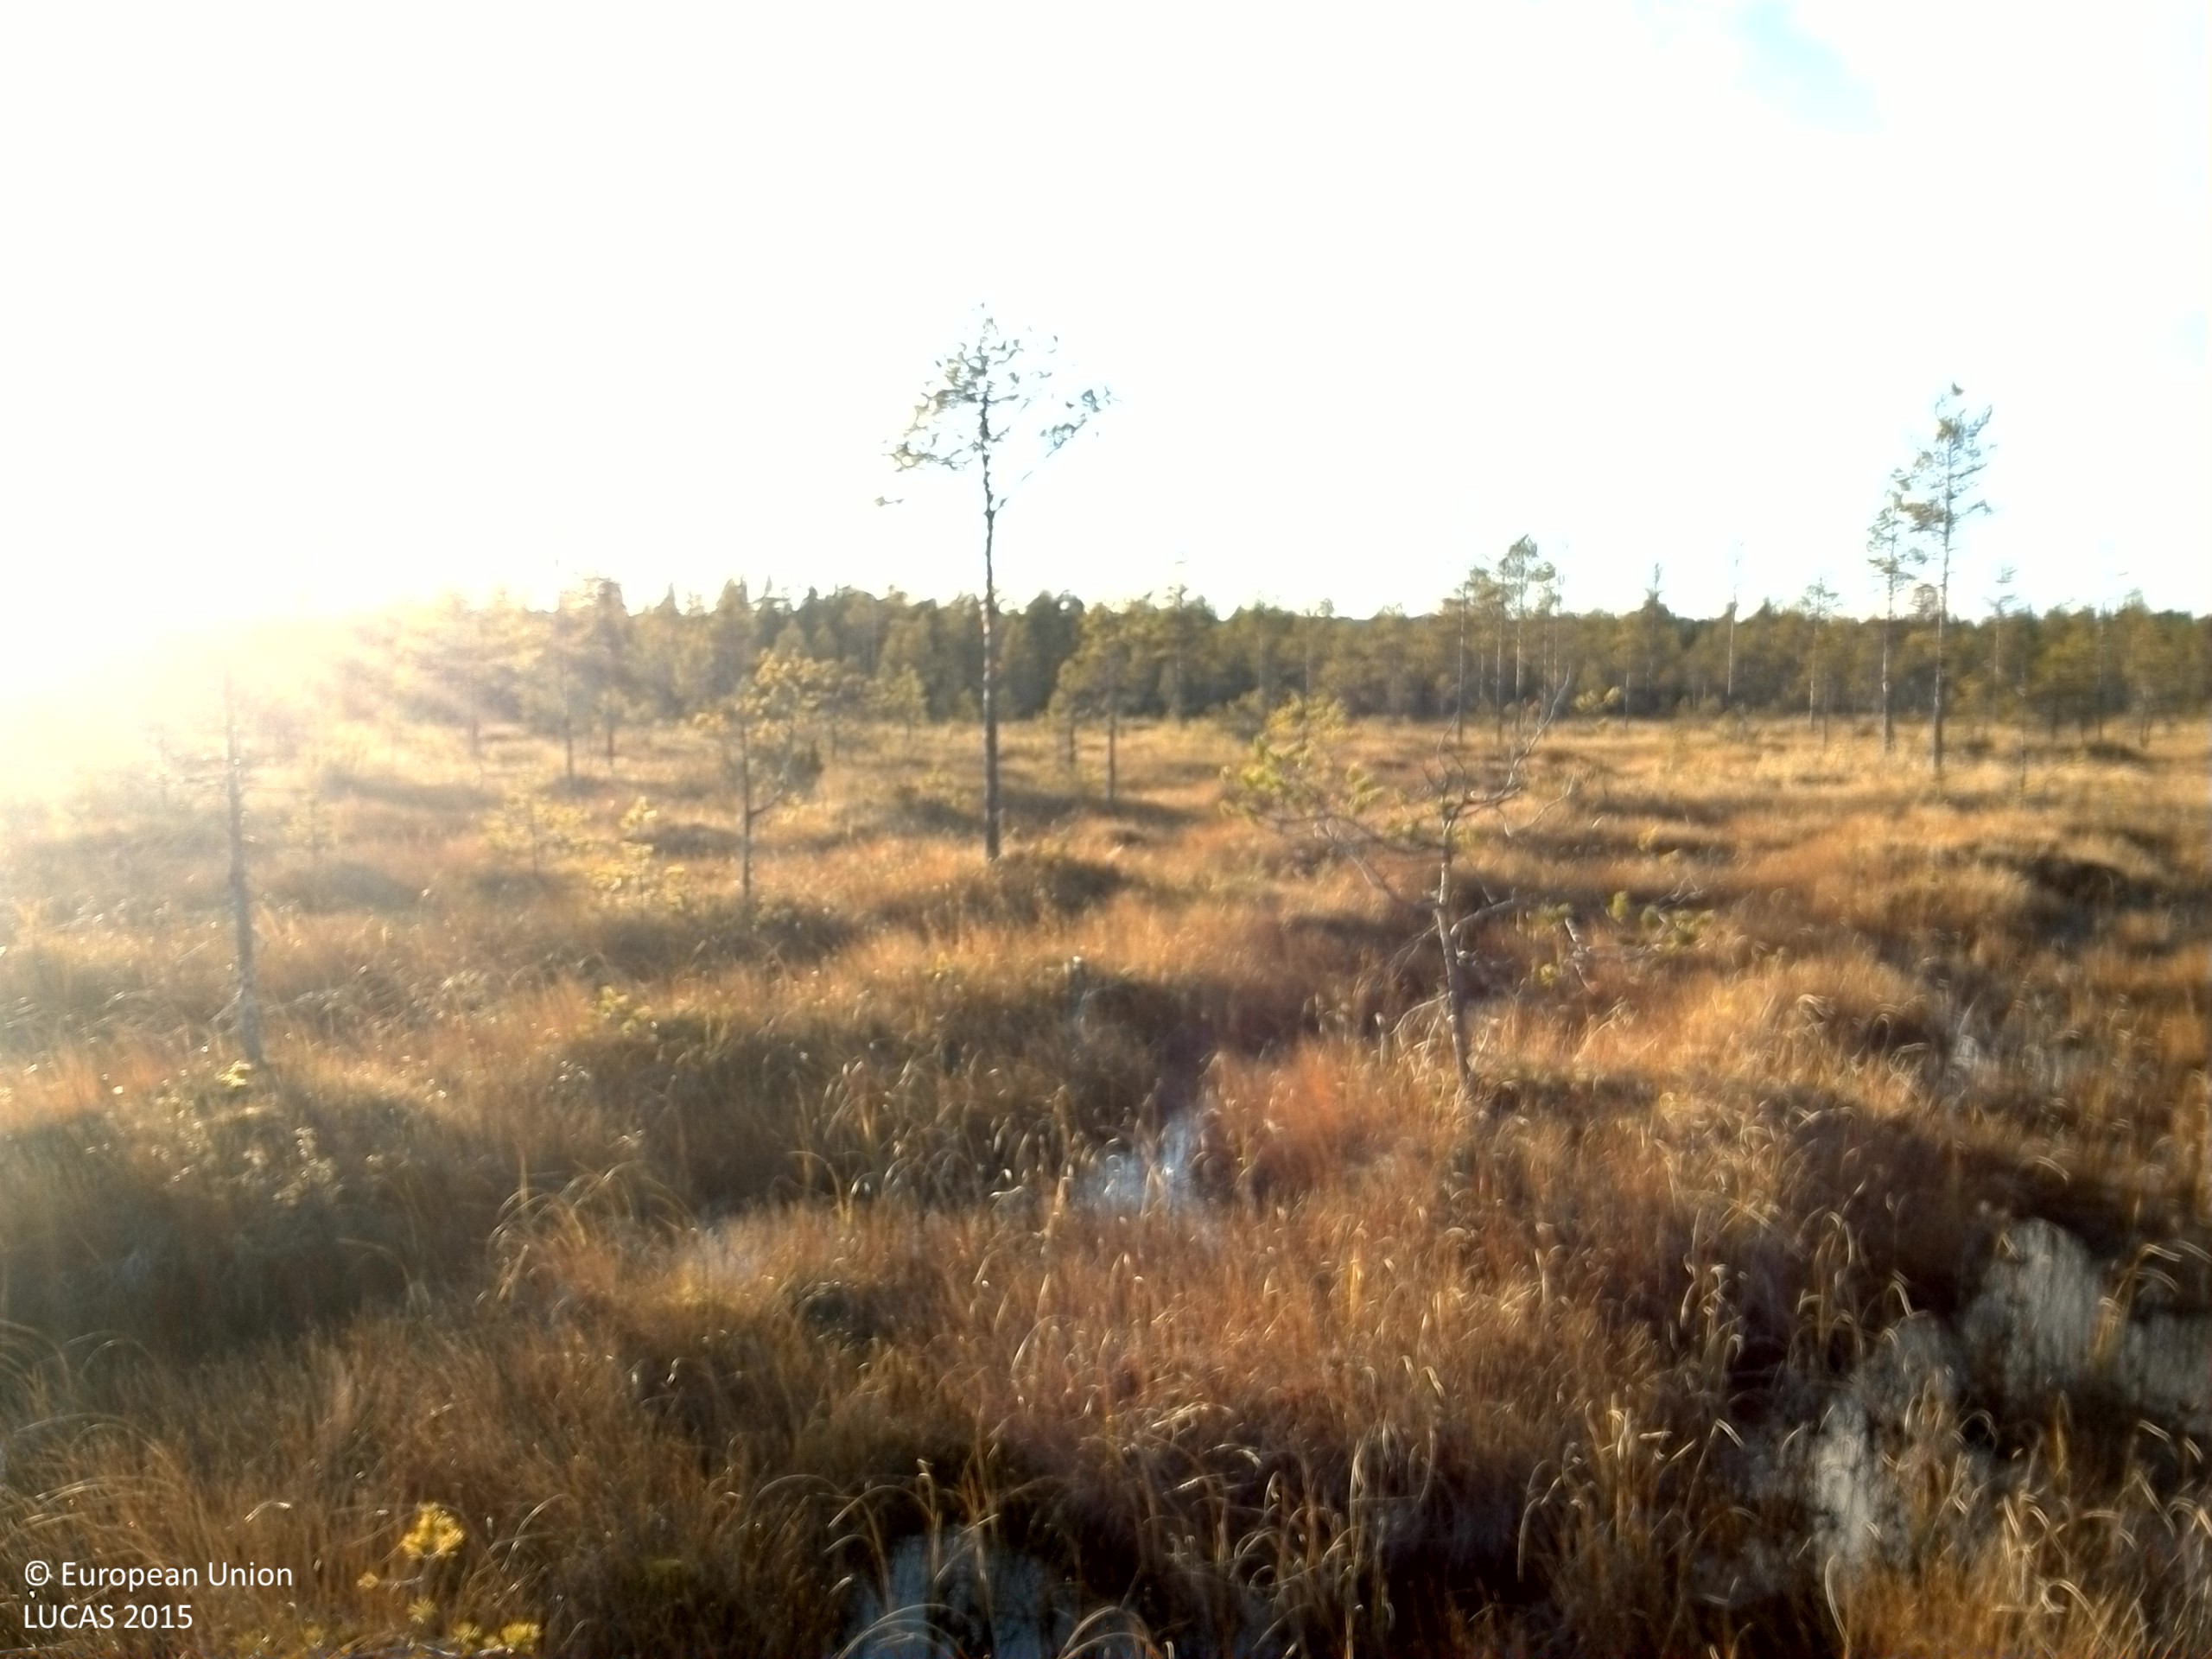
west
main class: Woodland
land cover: Pine dominated coniferous woodland
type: mire and swamp forests
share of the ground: 10 - 25 %
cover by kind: herbaceous plants 50 %, lichens and mosses 35 %, coniferous forest trees 10 %, shrubs 5 %
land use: Semi-natural and natural areas not in use
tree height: < 5 m
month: October
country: SE
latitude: 64.4232
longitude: 15.6791
